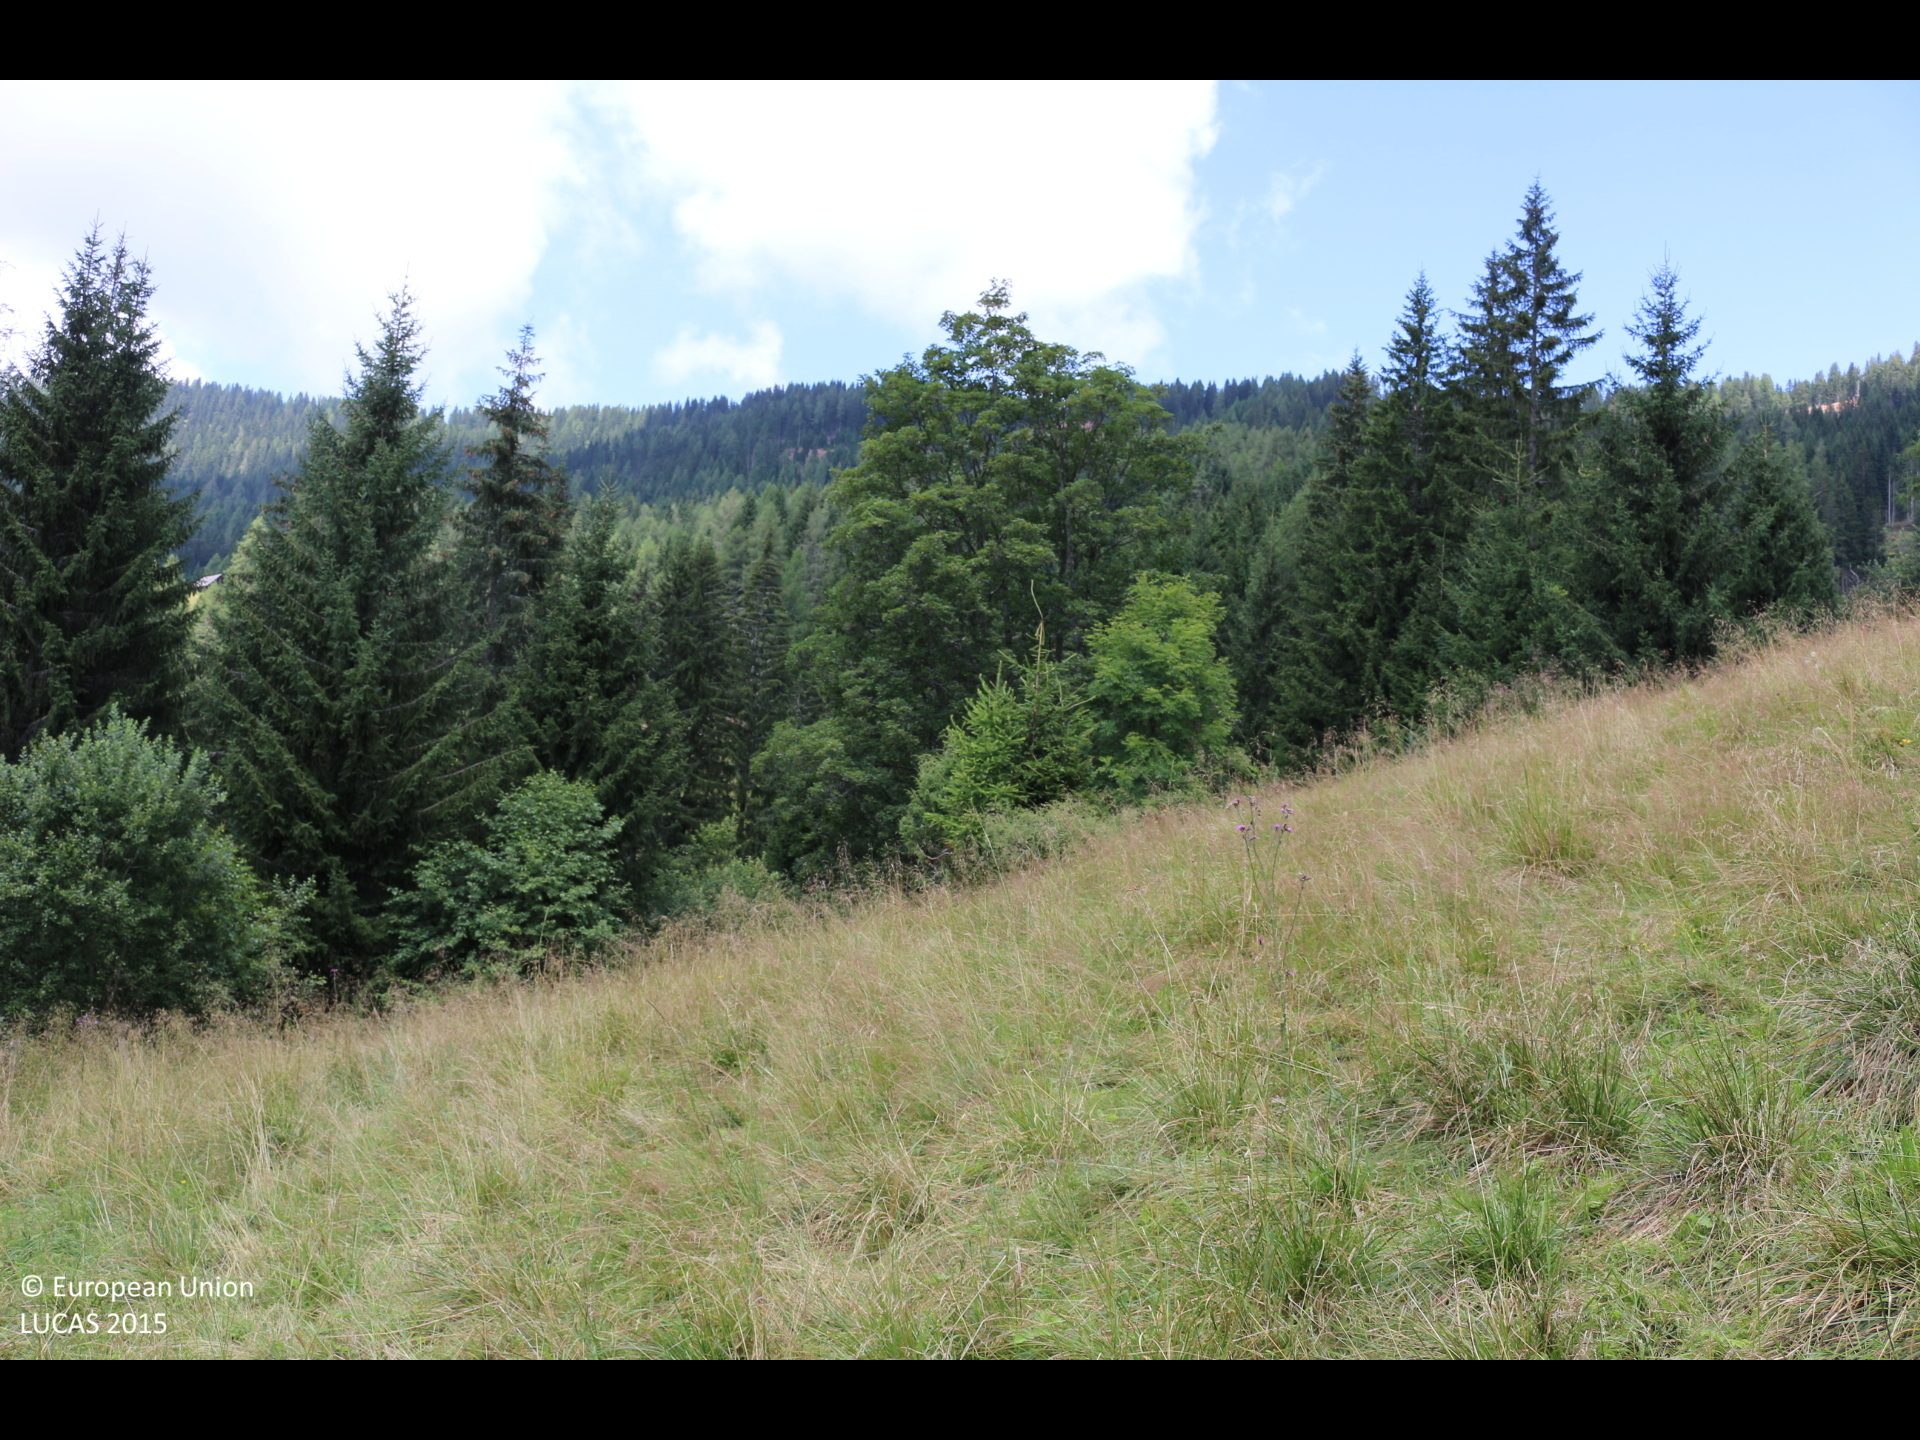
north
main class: Grassland
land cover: Grassland without tree/shrub cover
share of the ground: > 75 %
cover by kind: herbaceous plants 100 %
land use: Agriculture (excluding fallow land and kitchen gardens)
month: July
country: AT
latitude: 46.7475
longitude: 13.9375
